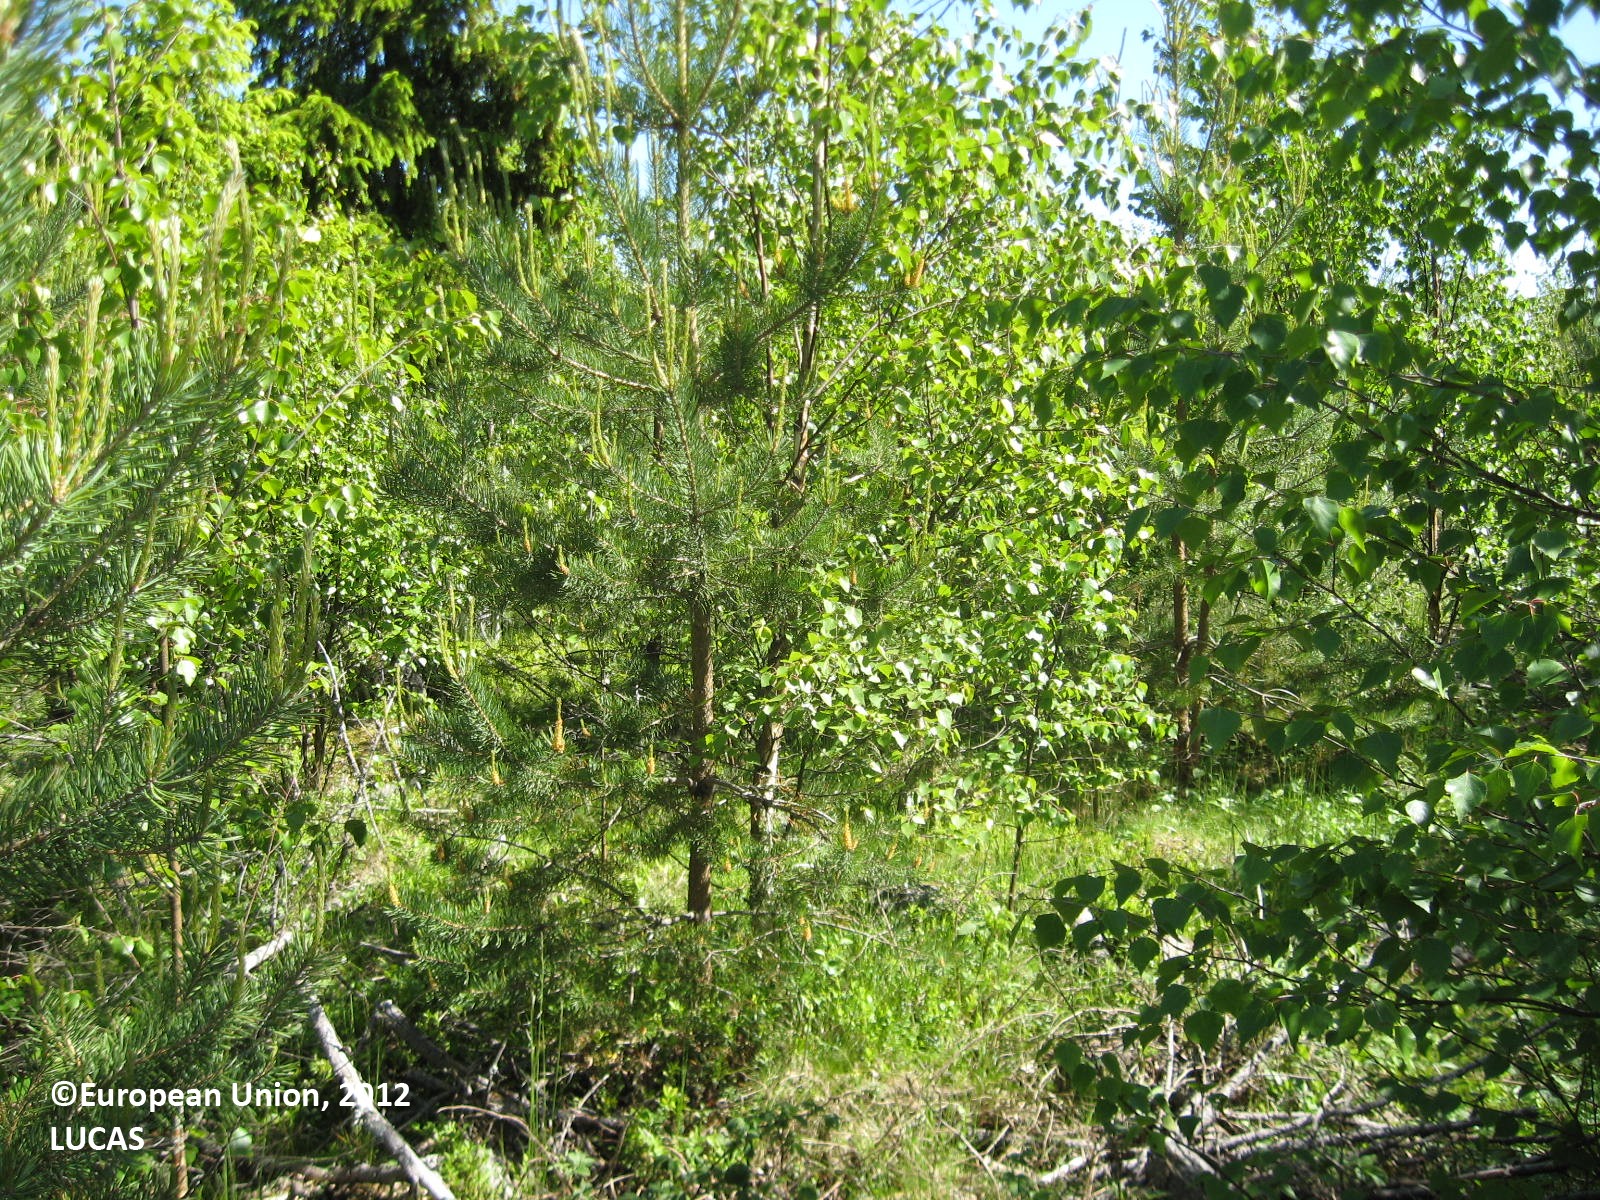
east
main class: Woodland
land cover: Pine dominated mixed woodland
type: boreal forest
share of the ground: > 75 %
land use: Forestry
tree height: < 5 m
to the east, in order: Pine dominated mixed woodland; Other mixed woodland; Ditches and canals; Other mixed woodland; Pine dominated coniferous woodland; Inland marshes; Pine dominated coniferous woodland
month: June
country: FI
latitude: 62.7987
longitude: 21.1558
